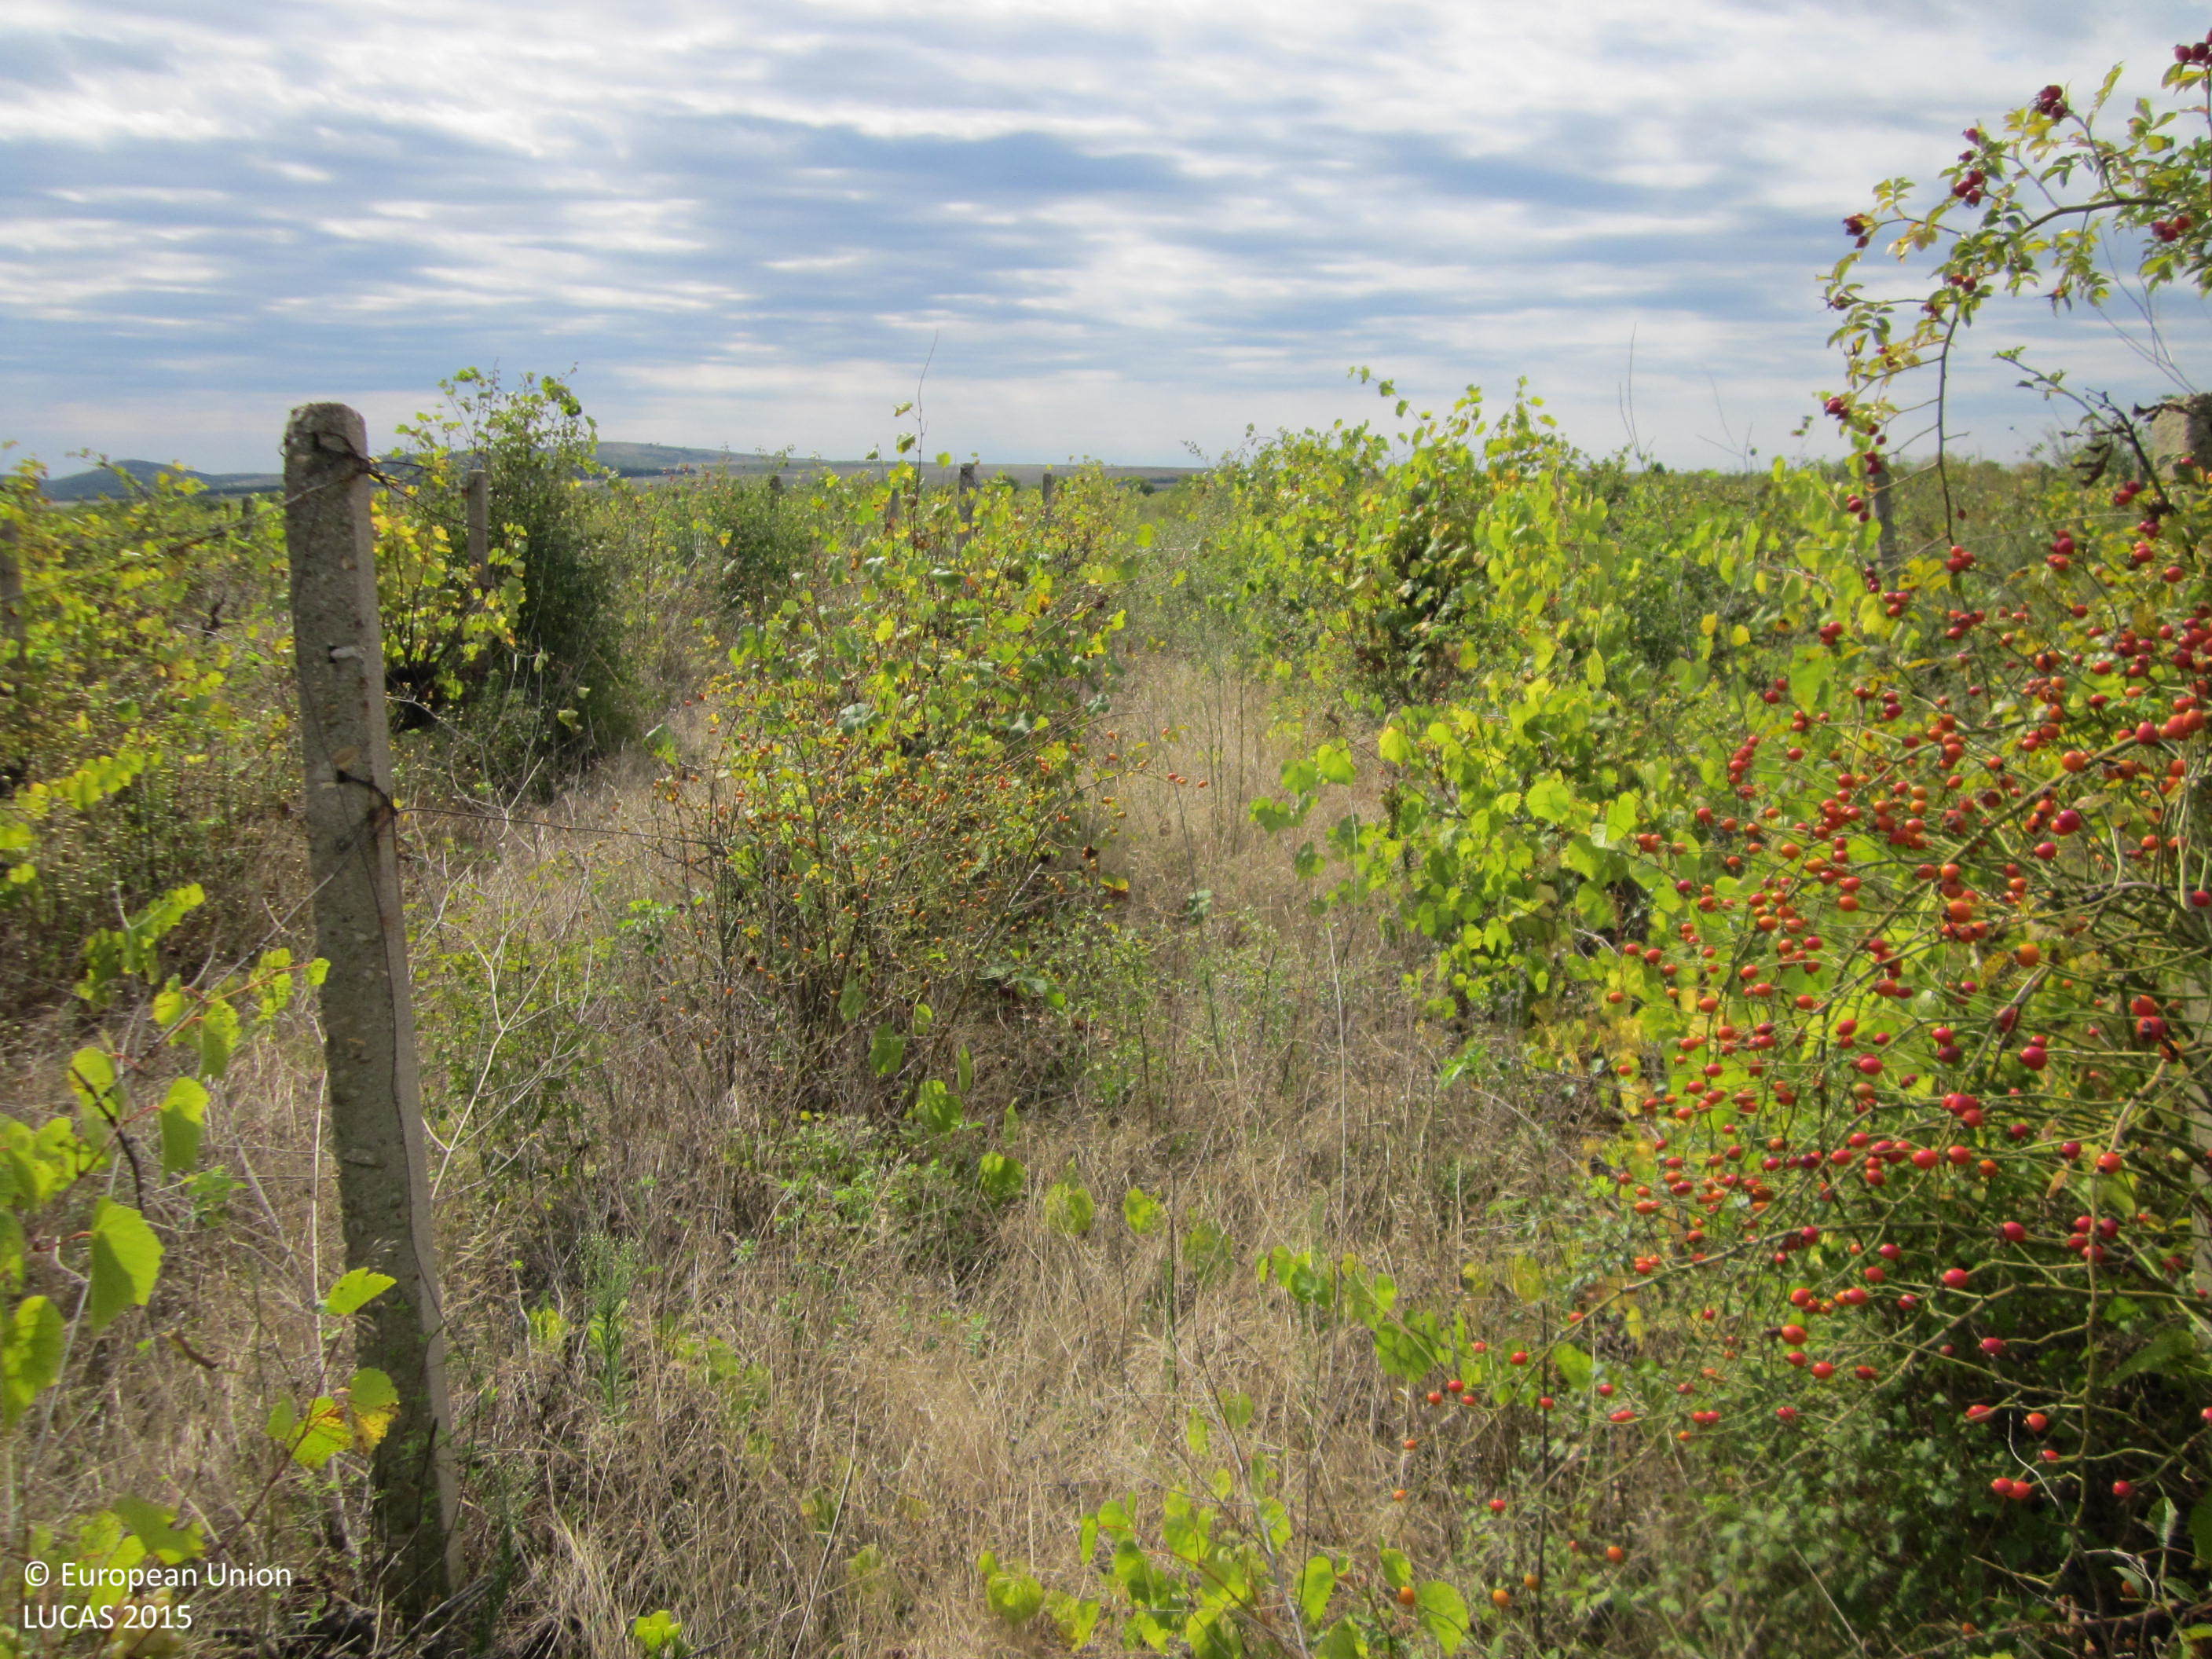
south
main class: Cropland
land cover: Vineyards
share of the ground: 50 - 75 %
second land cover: Spontaneously vegetated surfaces
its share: > 75 %
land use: Agriculture (excluding fallow land and kitchen gardens)
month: September
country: BG
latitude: 42.6908
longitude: 27.1377
